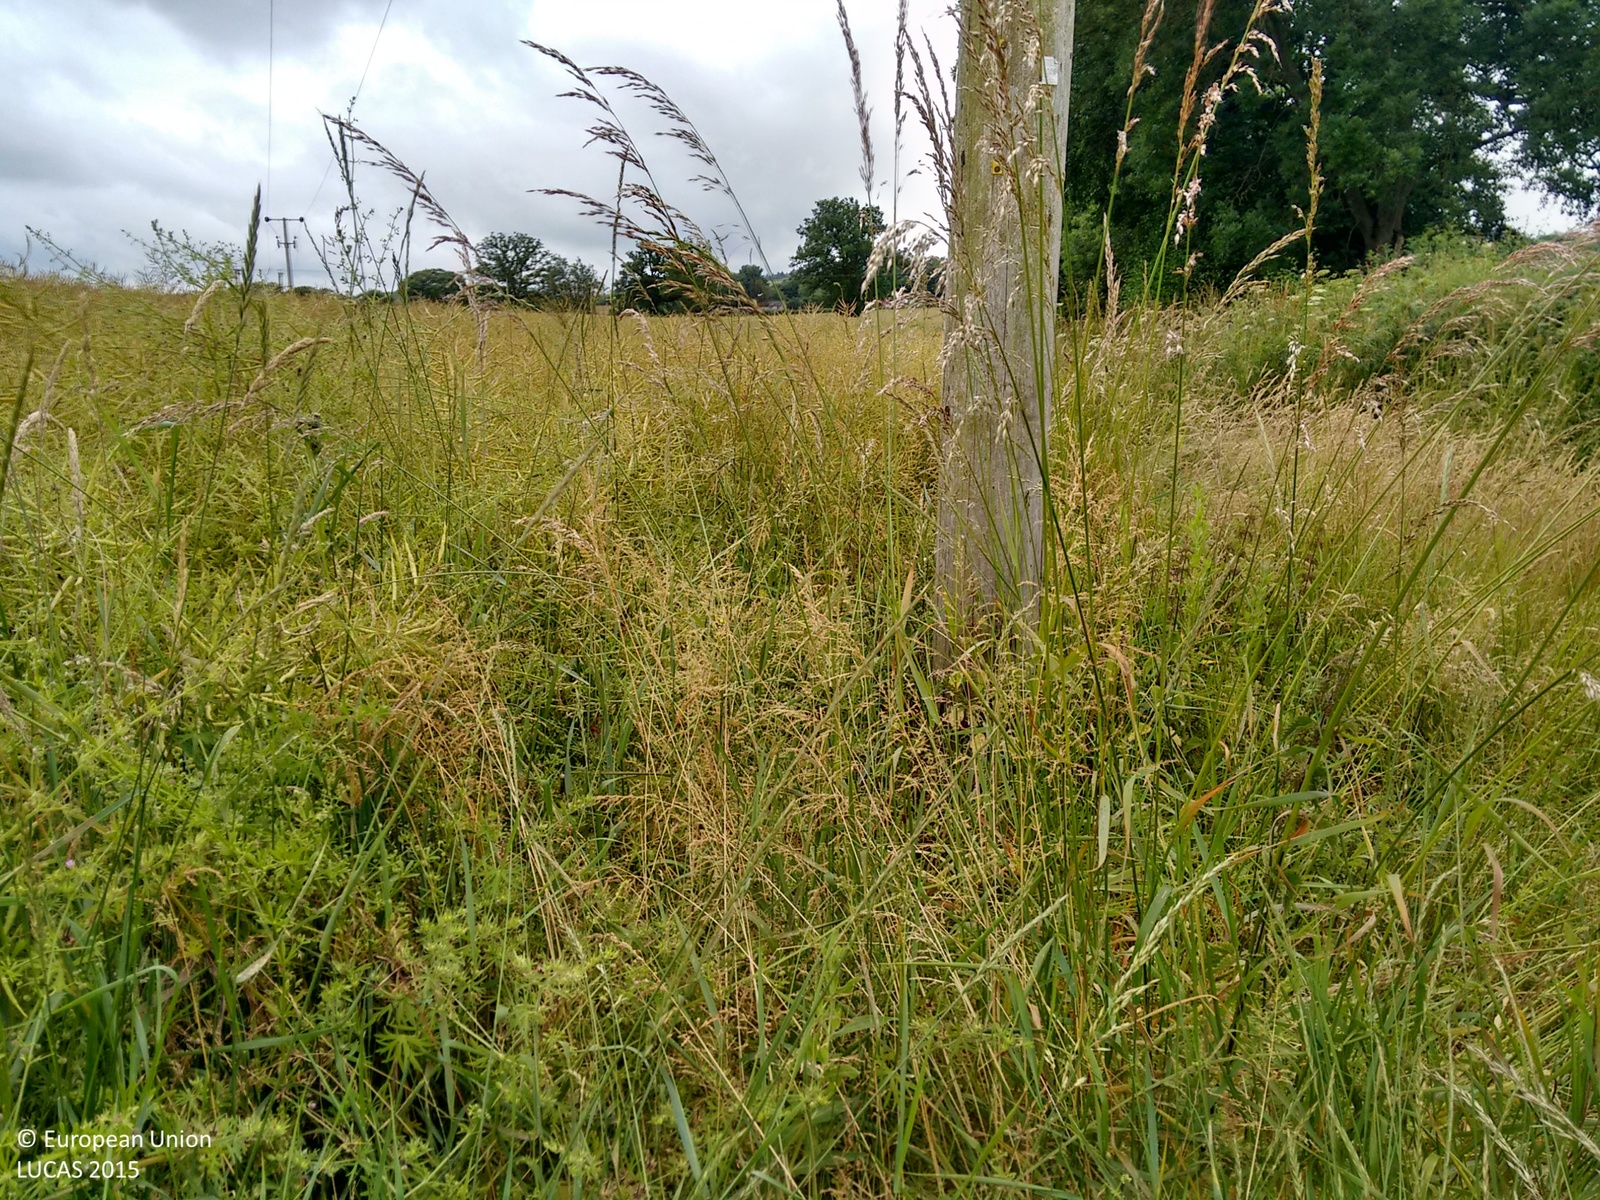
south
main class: Cropland
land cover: Rape and turnip rape
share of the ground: > 75 %
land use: Agriculture (excluding fallow land and kitchen gardens)
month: July
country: GB
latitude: 52.0555
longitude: -2.5363
